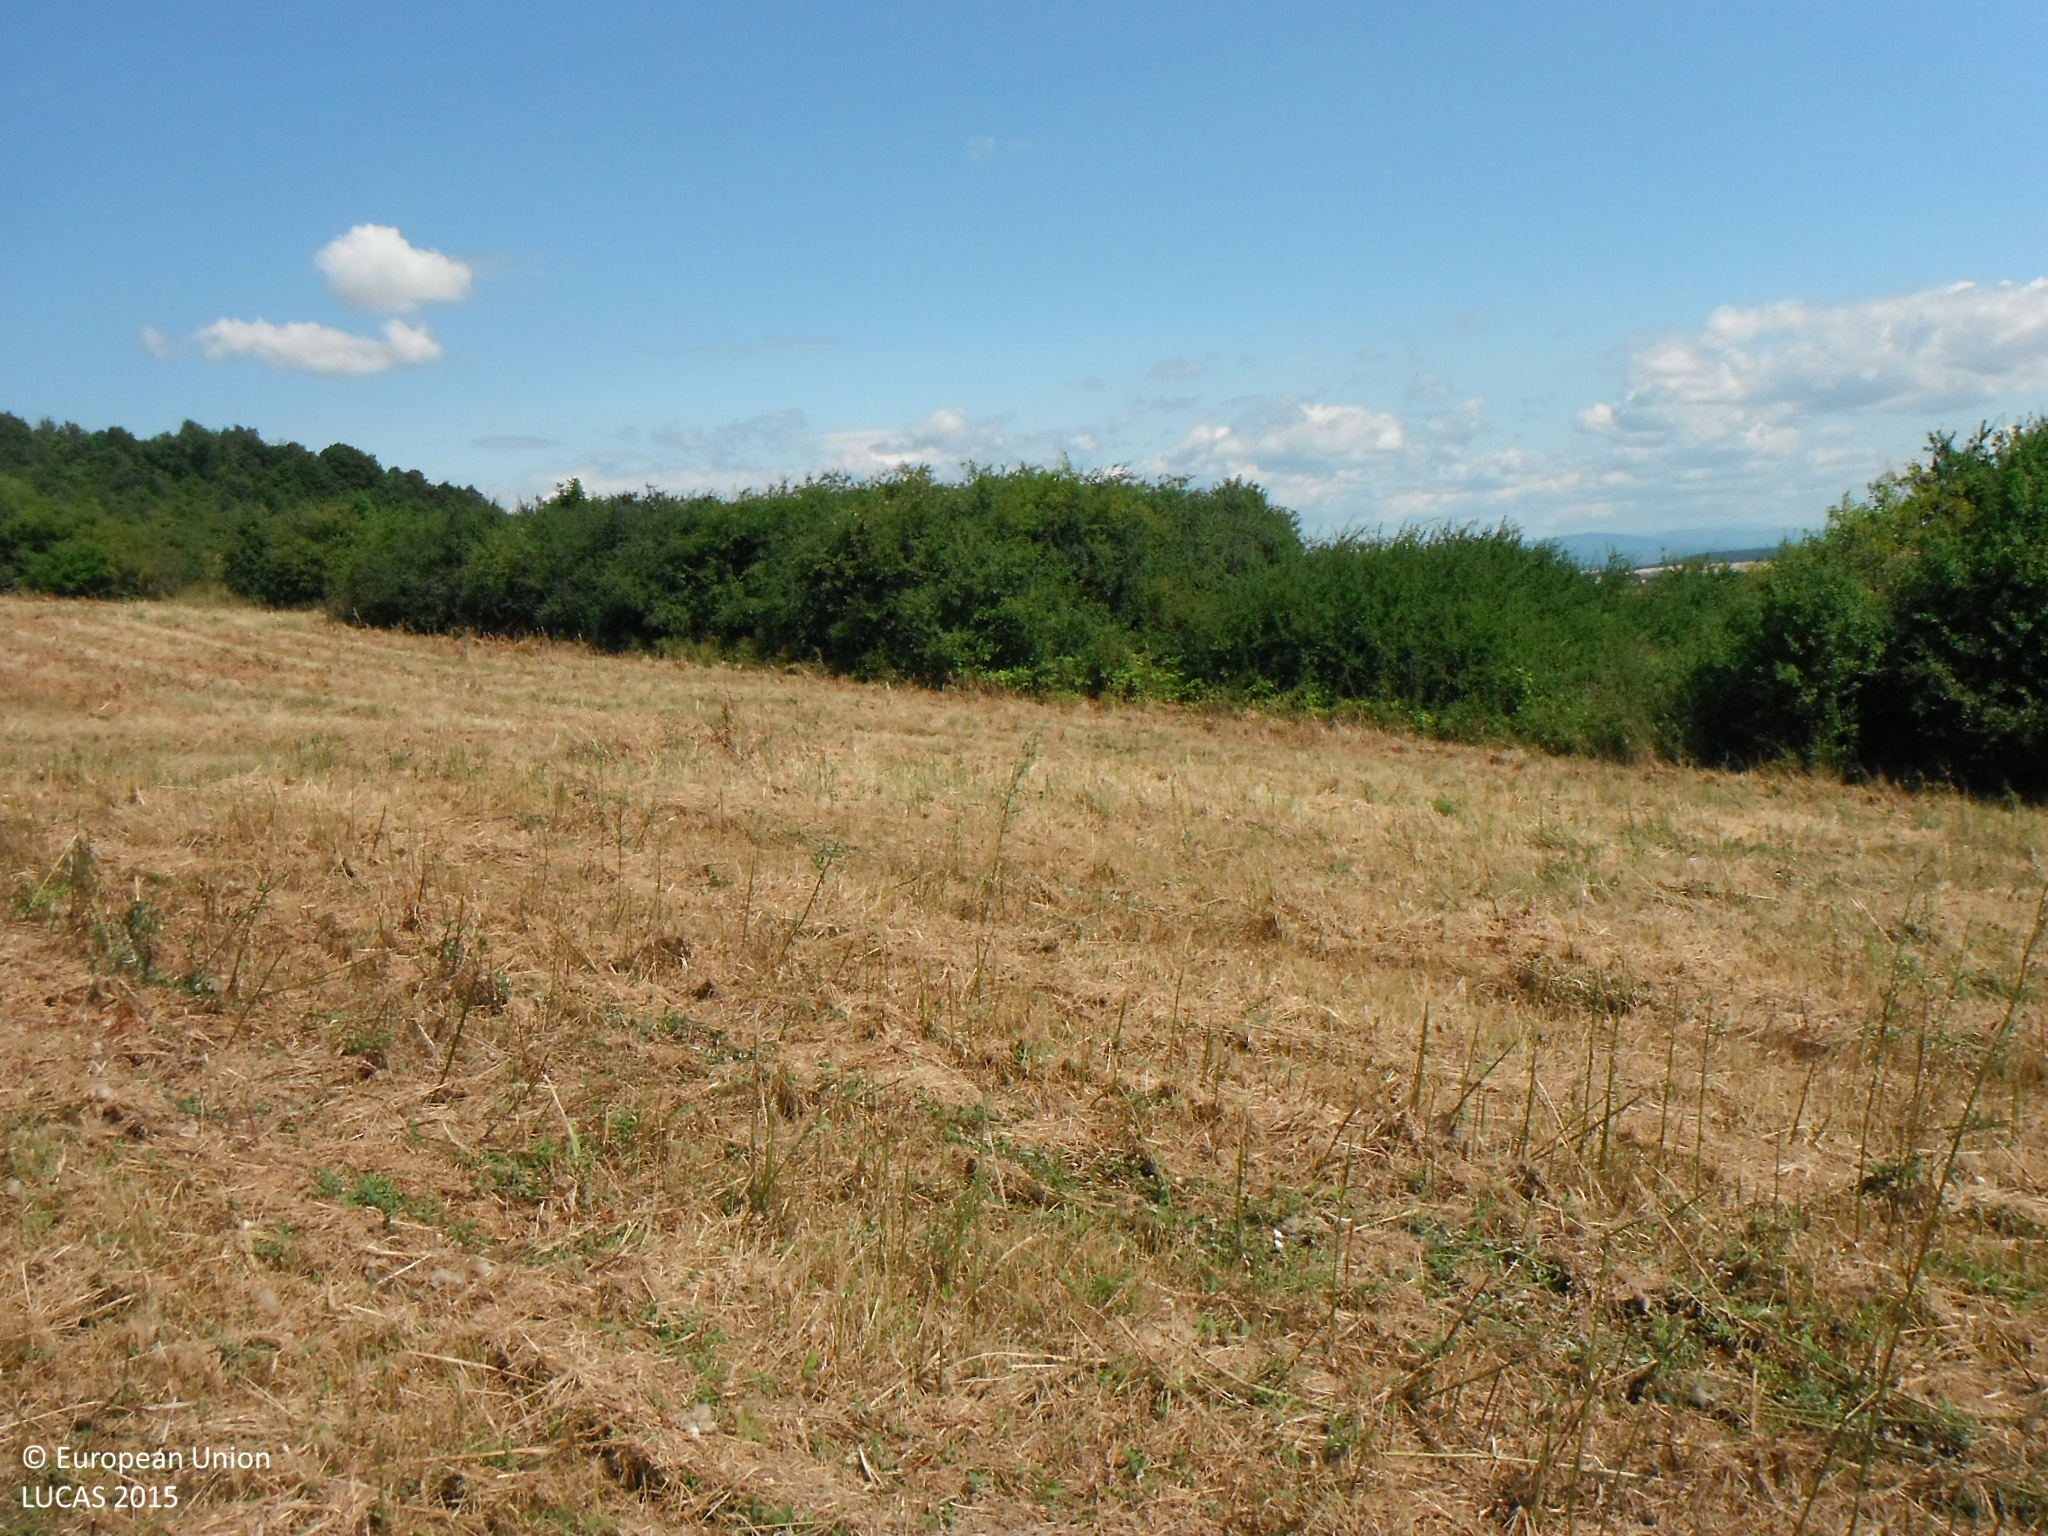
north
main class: Grassland
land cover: Grassland without tree/shrub cover
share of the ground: > 75 %
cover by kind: herbaceous plants 95 %, shrubs 5 %
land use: Agriculture (excluding fallow land and kitchen gardens)
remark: Harvested field
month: July
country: SK
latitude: 48.2578
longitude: 19.7924
